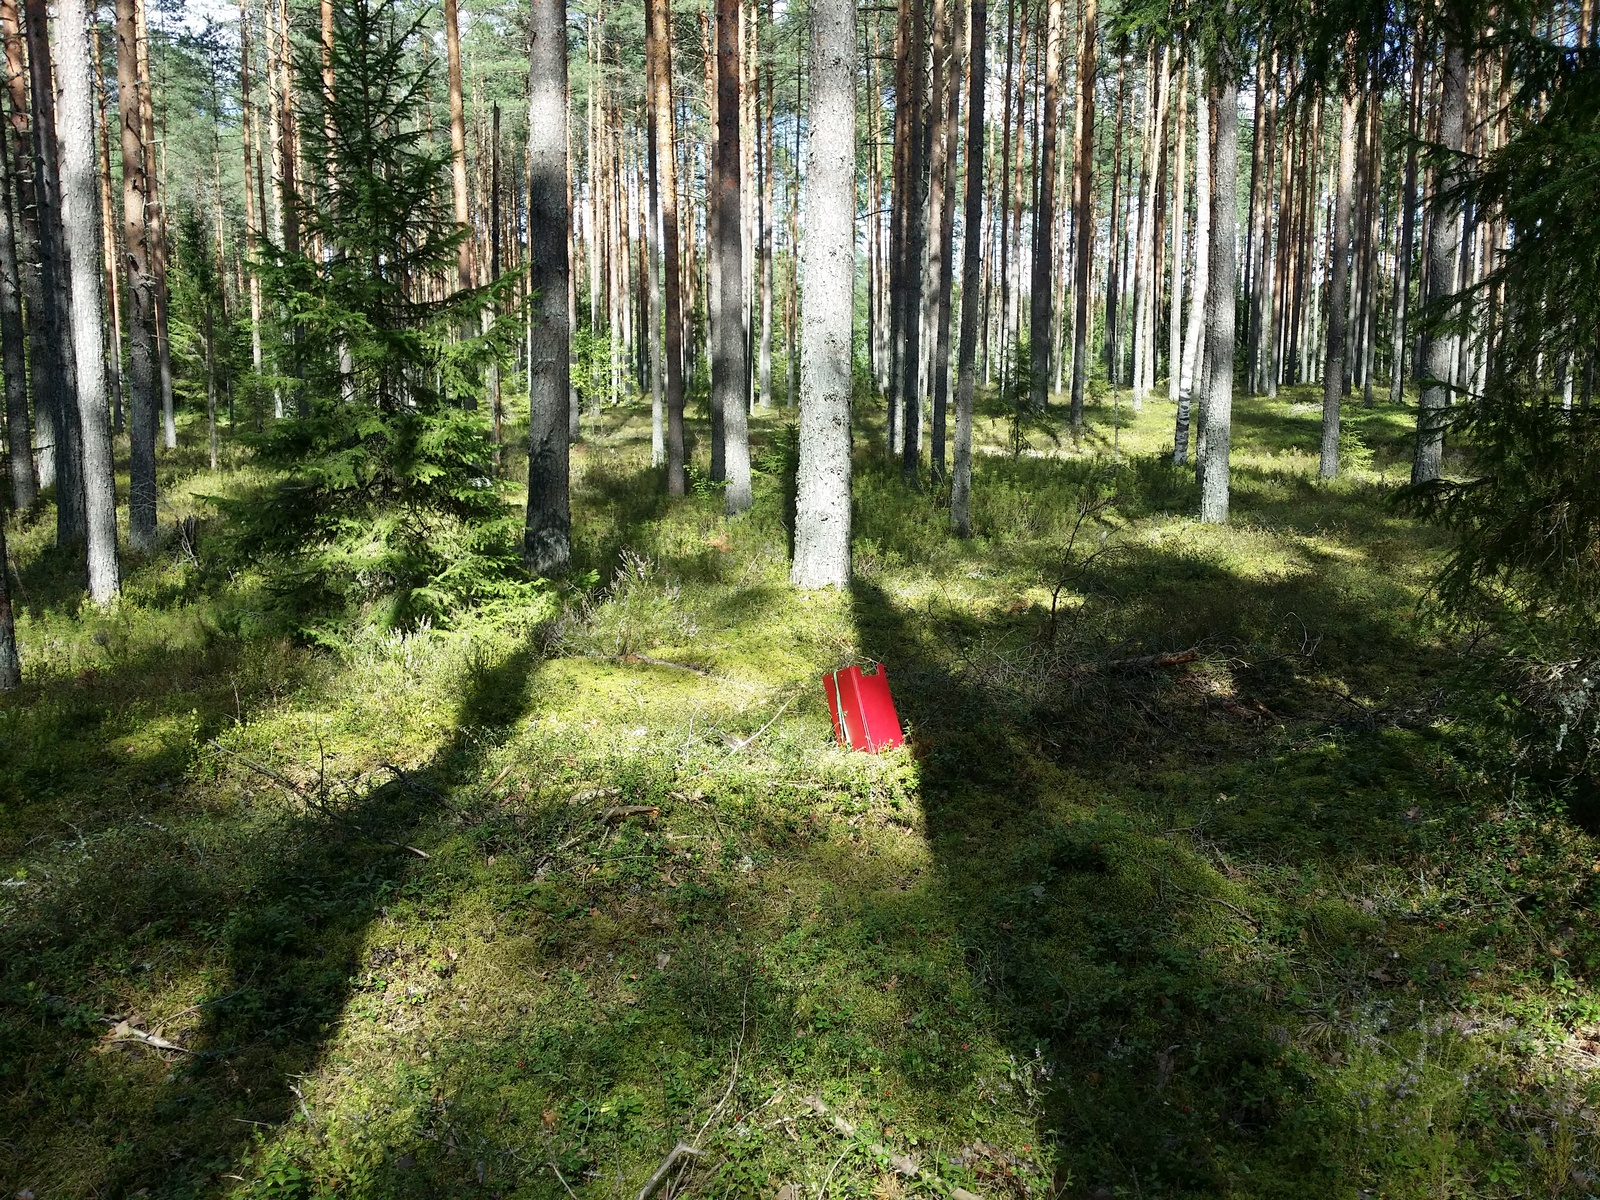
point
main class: Woodland
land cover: Pine dominated coniferous woodland
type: hemiboreal forest and nemoral coniferous forest and mixed broadleaved-coniferous forest
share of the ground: 50 - 75 %
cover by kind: coniferous forest trees 70 %, lichens and mosses 25 %, shrubs 5 %
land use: Forestry
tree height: > 5 m
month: August
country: LV
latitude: 57.3119
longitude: 27.6622
